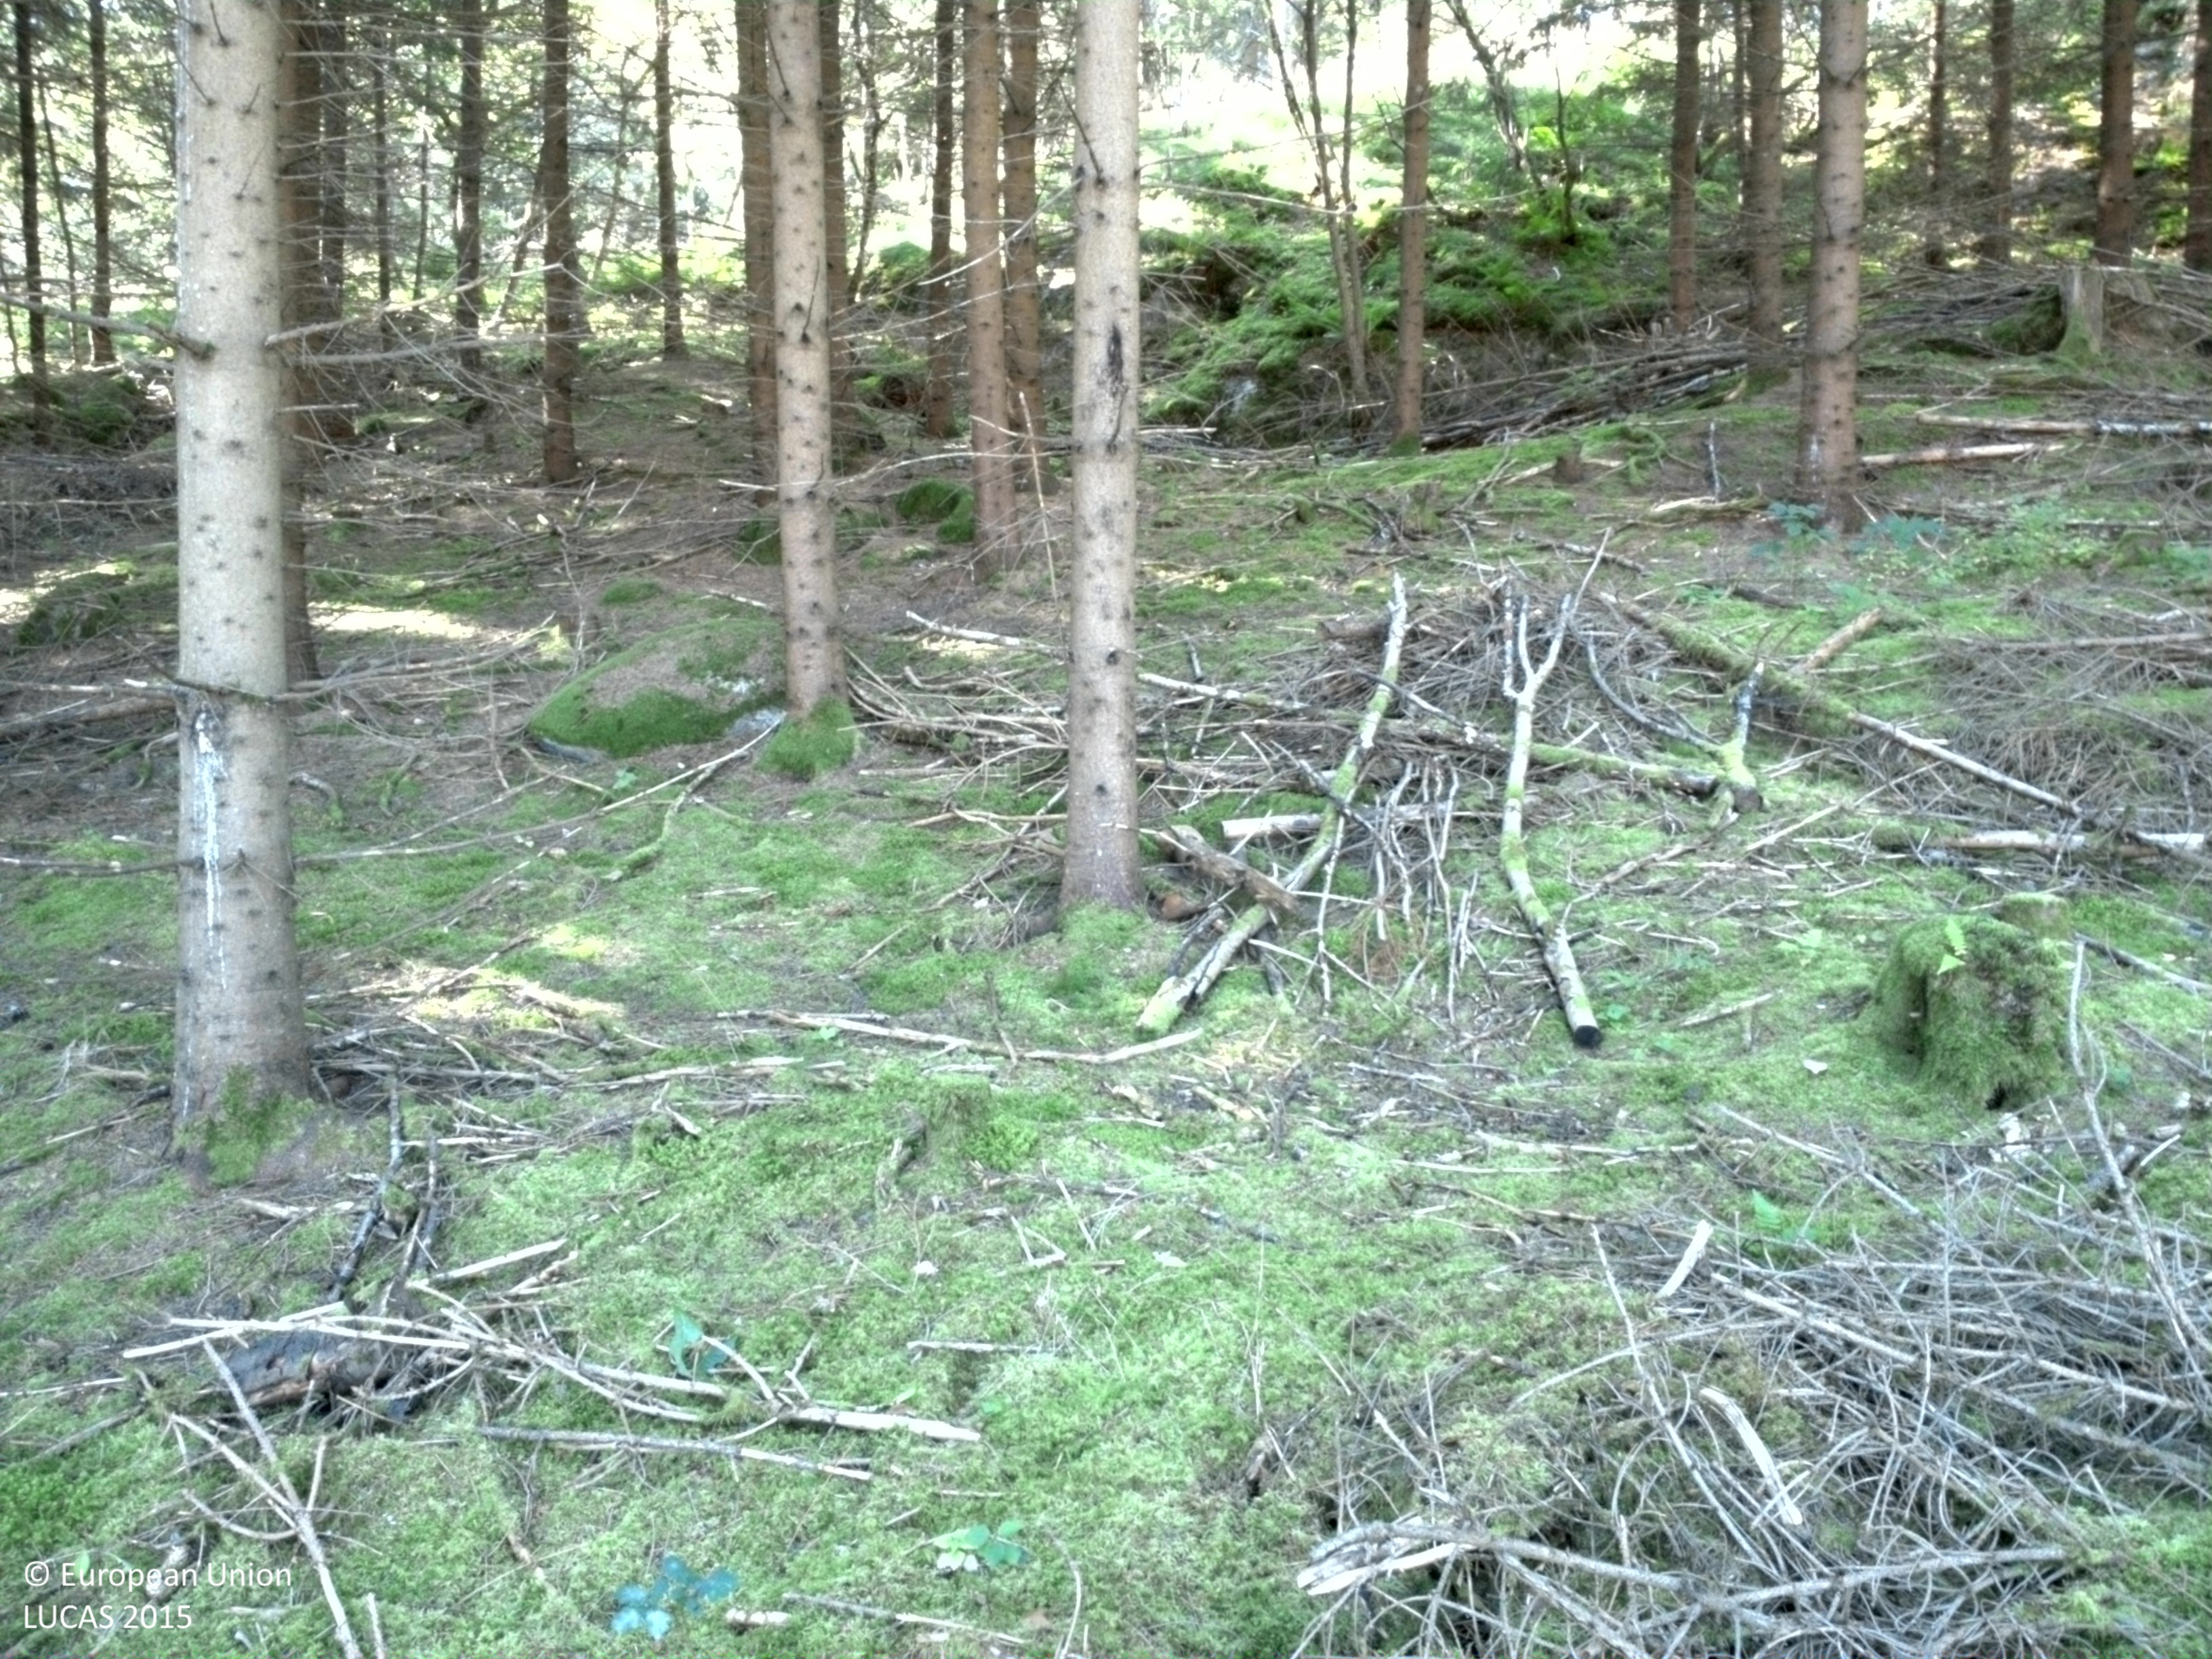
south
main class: Woodland
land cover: Spruce dominated coniferous woodland
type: boreal forest
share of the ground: > 75 %
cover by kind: coniferous forest trees 90 %, herbaceous plants 5 %, lichens and mosses 5 %
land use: Forestry
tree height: > 5 m
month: August
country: SE
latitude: 59.6036
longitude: 17.4544
